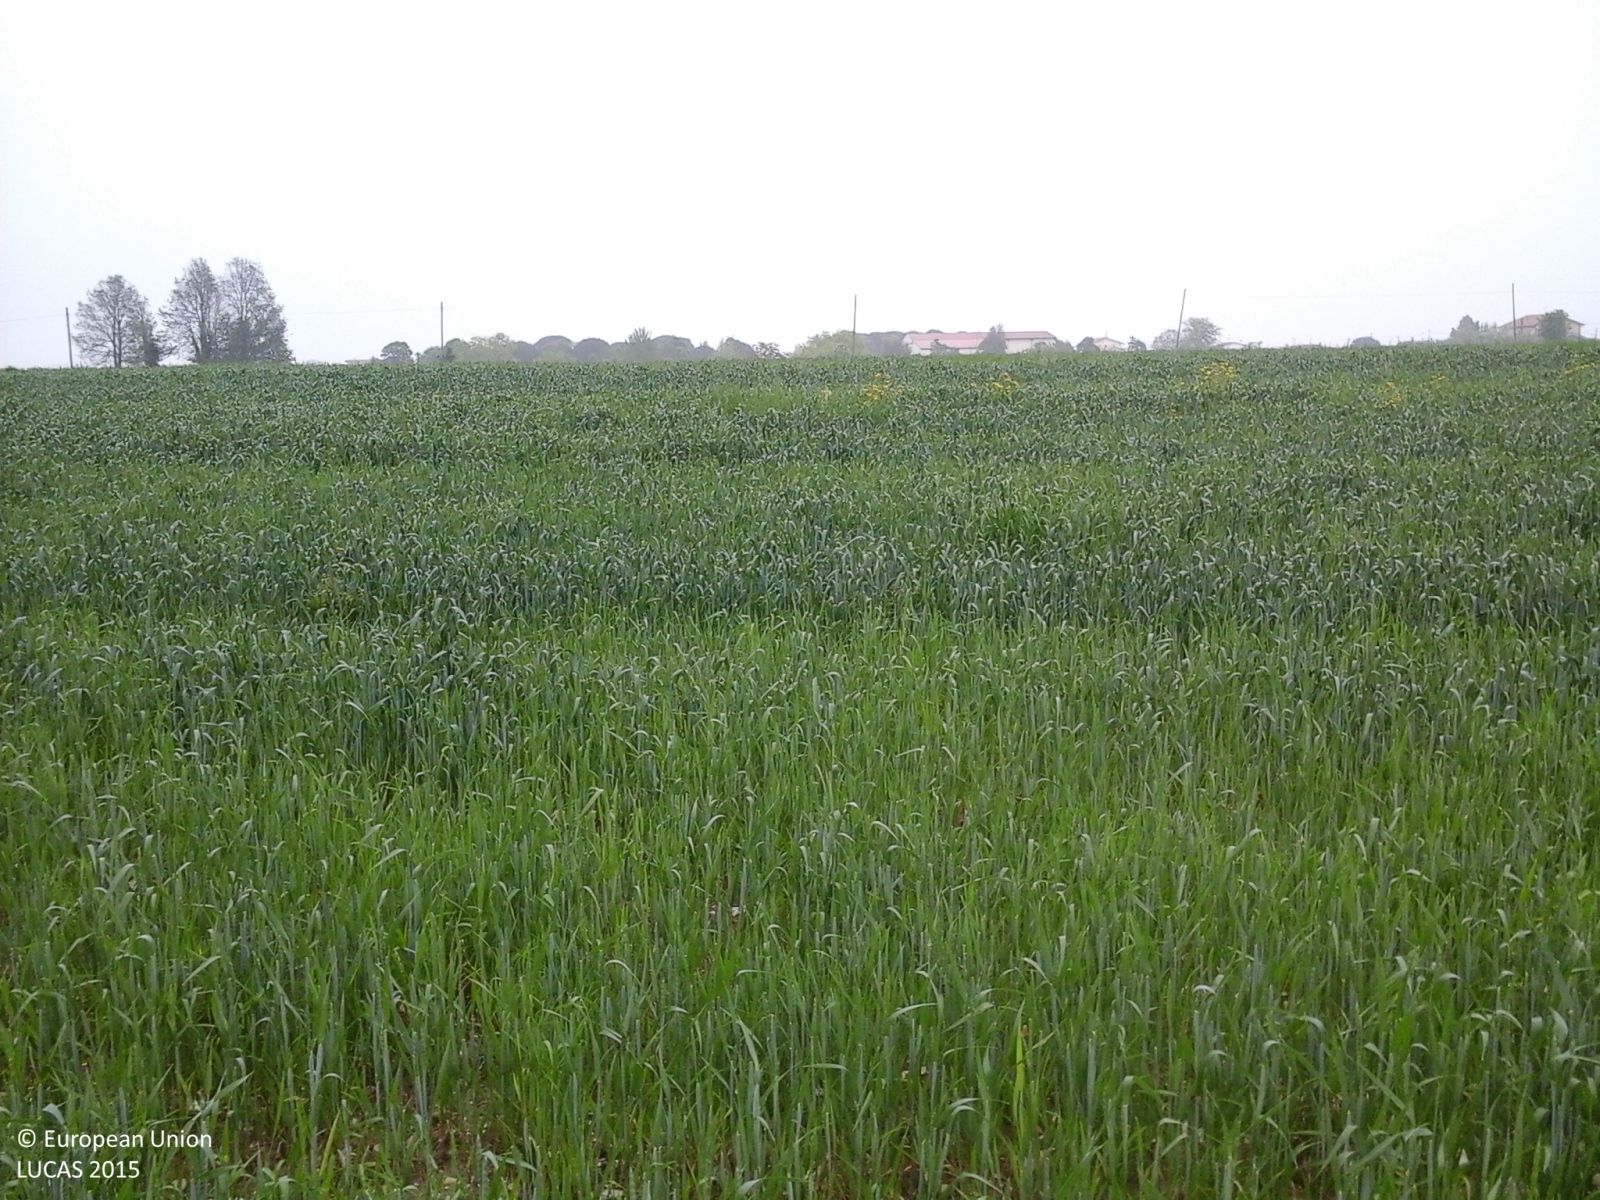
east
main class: Cropland
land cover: Common wheat
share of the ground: > 75 %
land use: Agriculture (excluding fallow land and kitchen gardens)
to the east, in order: Common wheat; Ditches and canals; Common wheat; Ditches and canals; Common wheat; Ditches and canals; Common wheat; Ditches and canals; Common wheat; Electric lines; Common wheat; Ditches and canals; Common wheat; Ditches and canals; Other leguminous and mixtures for fodder; Lucerne; Single bushes/trees; Spontaneously vegetated surfaces
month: May
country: IT
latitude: 44.1050
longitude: 12.4555
